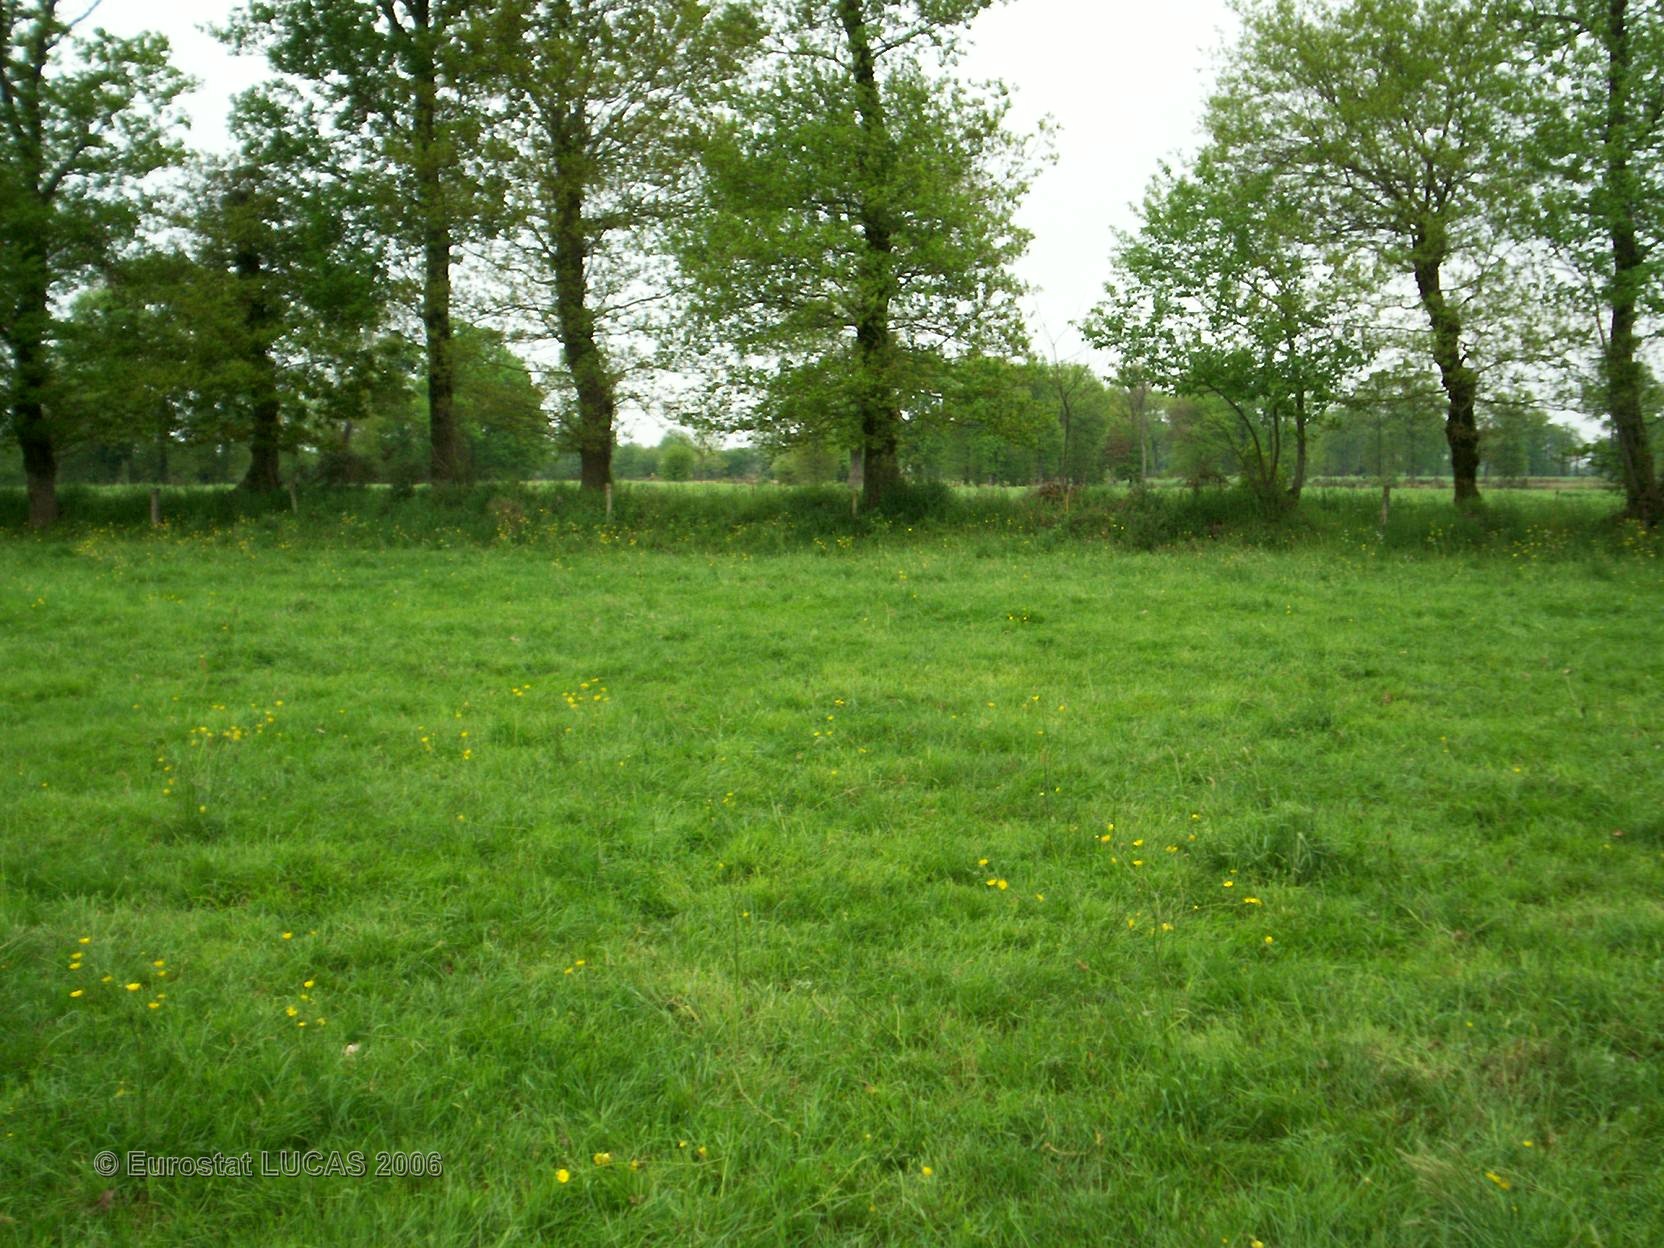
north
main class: Grassland
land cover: Grassland without tree/shrub cover
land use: Agriculture (excluding fallow land and kitchen gardens)
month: May
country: FR
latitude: 48.2938
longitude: -1.6540
